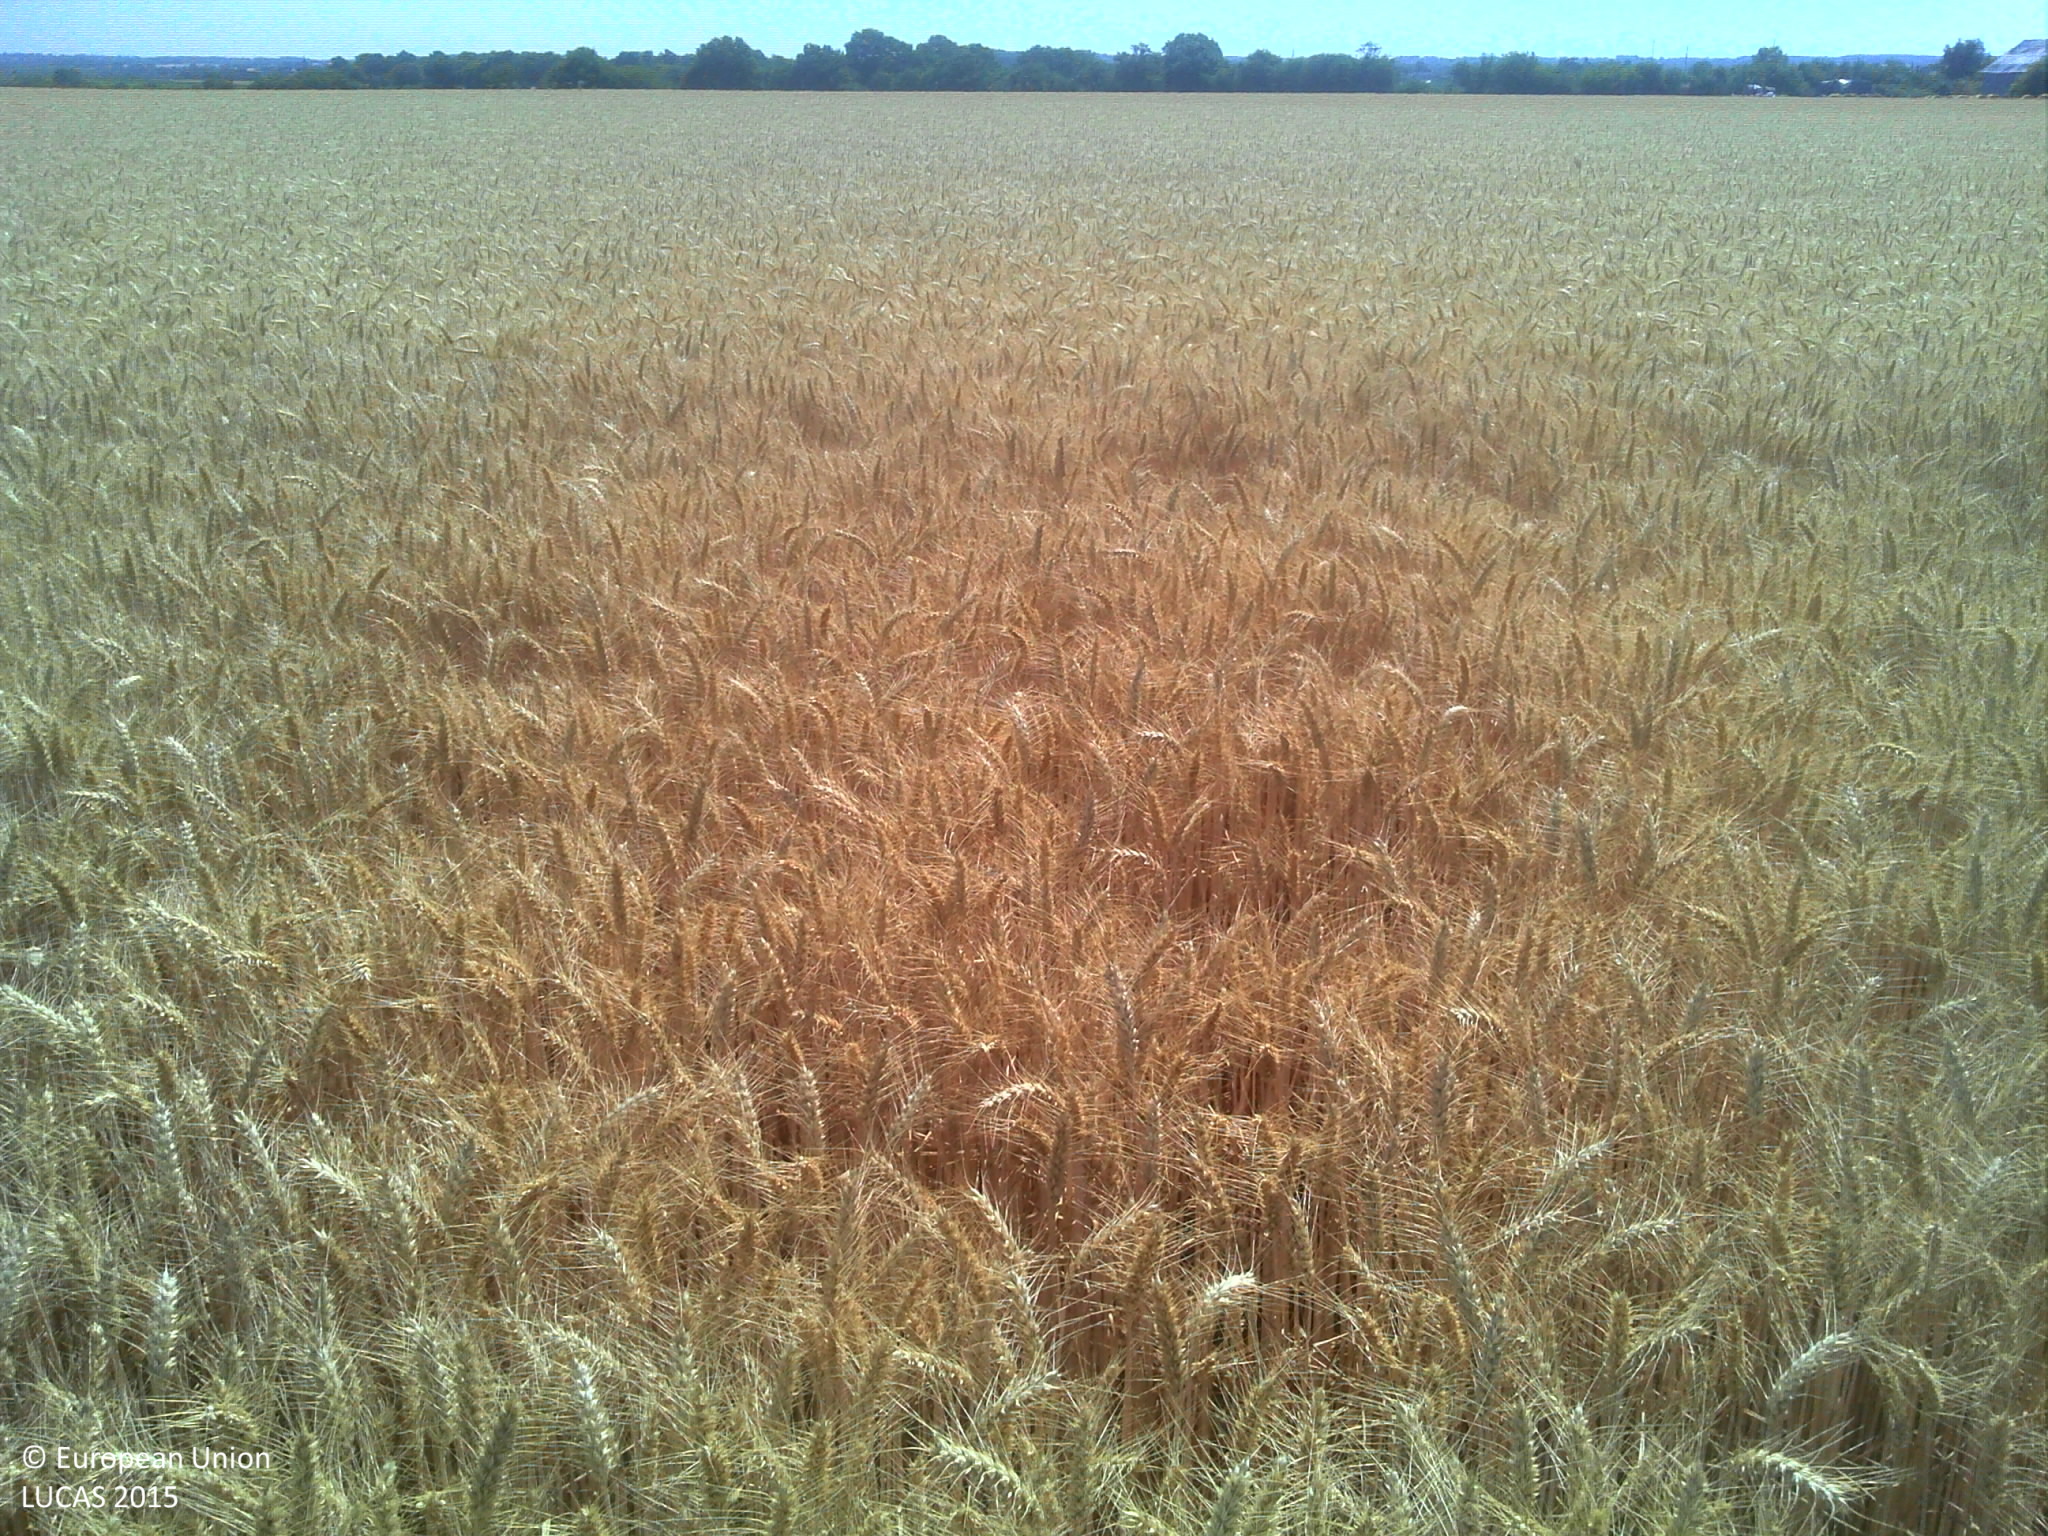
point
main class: Cropland
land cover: Durum wheat
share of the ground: > 75 %
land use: Agriculture (excluding fallow land and kitchen gardens)
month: July
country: FR
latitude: 47.9898
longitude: 0.8814
